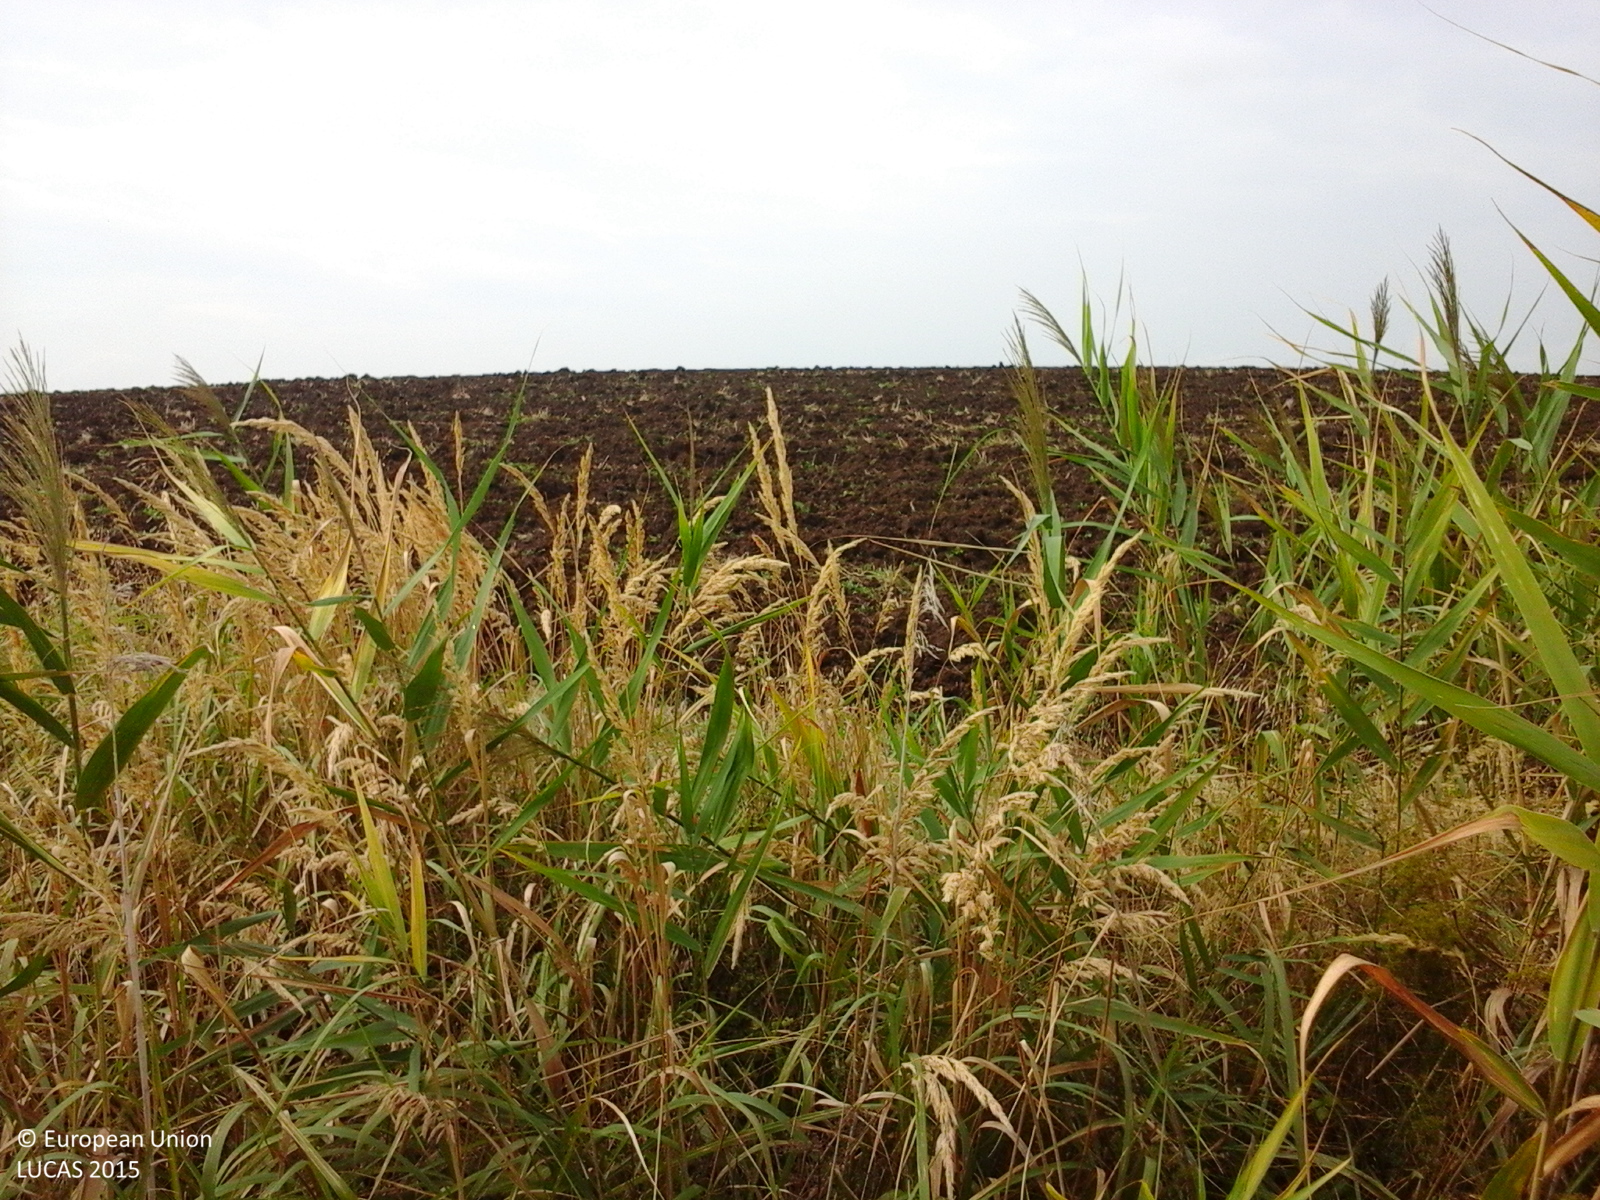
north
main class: Grassland
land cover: Spontaneously vegetated surfaces
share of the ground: > 75 %
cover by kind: herbaceous plants 100 %
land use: Semi-natural and natural areas not in use
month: August
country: RO
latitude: 45.8688
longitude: 21.3820
